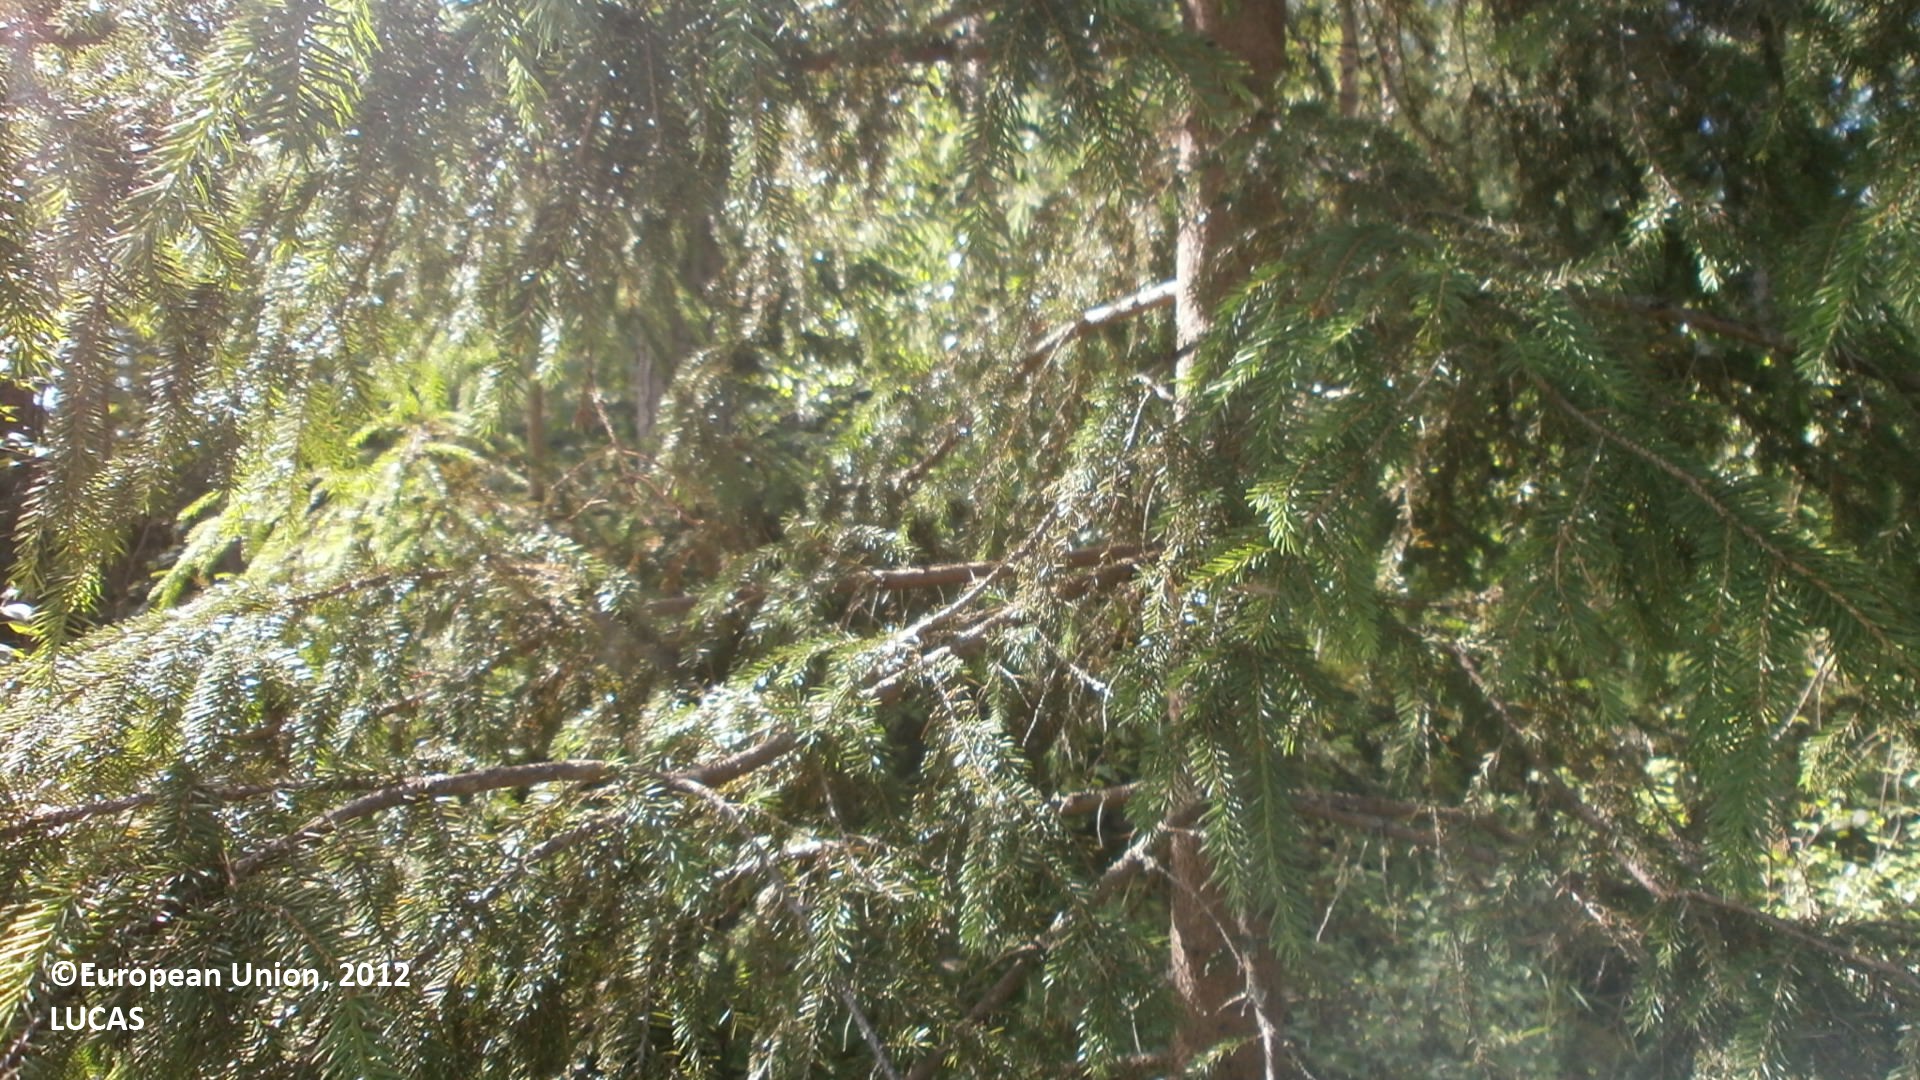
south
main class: Woodland
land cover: Pine dominated mixed woodland
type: boreal forest
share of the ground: 50 - 75 %
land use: Forestry
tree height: > 5 m
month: July
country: FI
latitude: 64.1189
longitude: 24.8435
